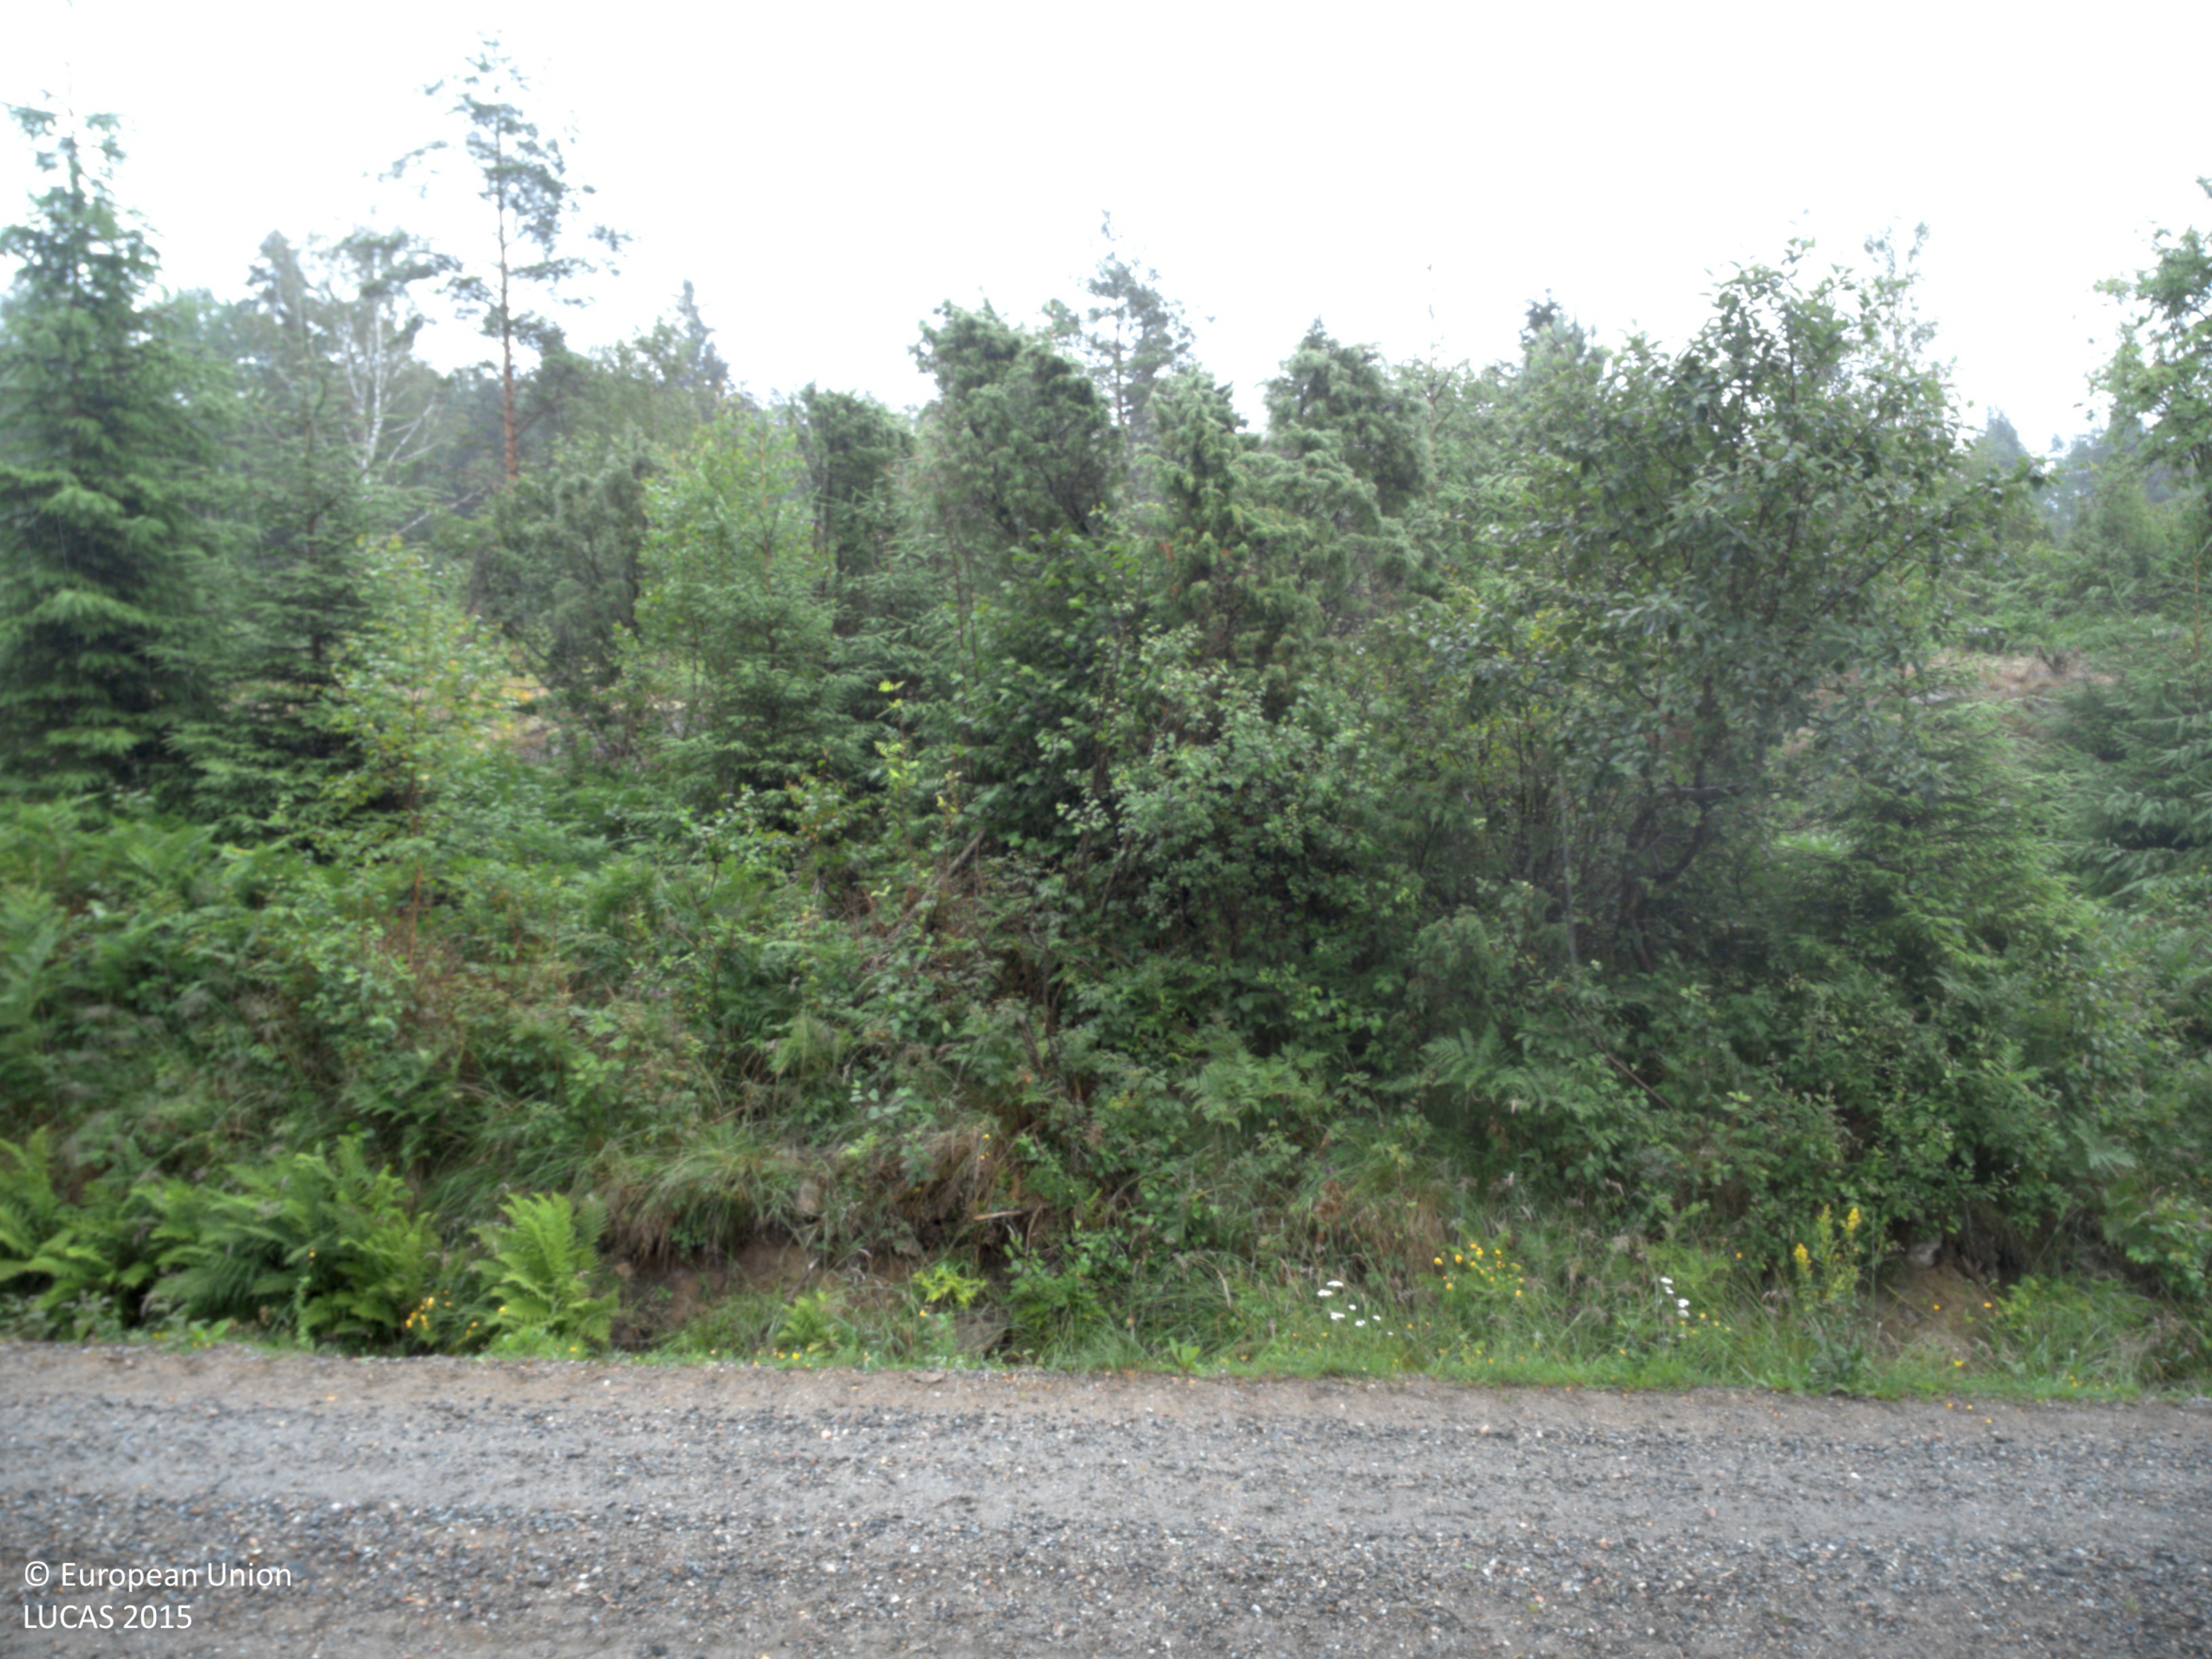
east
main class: Woodland
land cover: Spruce dominated mixed woodland
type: boreal forest
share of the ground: 50 - 75 %
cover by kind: coniferous forest trees 30 %, broadleaved forest trees 30 %, herbaceous plants 30 %, shrubs 10 %
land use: Forestry
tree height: > 5 m
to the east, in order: Spruce dominated mixed woodland; Ditches and canals; Paved roads, cycling and walking lanes; Ditches and canals; Spruce dominated mixed woodland; Electric lines; Spruce dominated mixed woodland; Dry stone walls; Pine dominated mixed woodland; Pine dominated coniferous woodland; Pine dominated mixed woodland
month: July
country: SE
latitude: 58.6751
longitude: 11.8068
